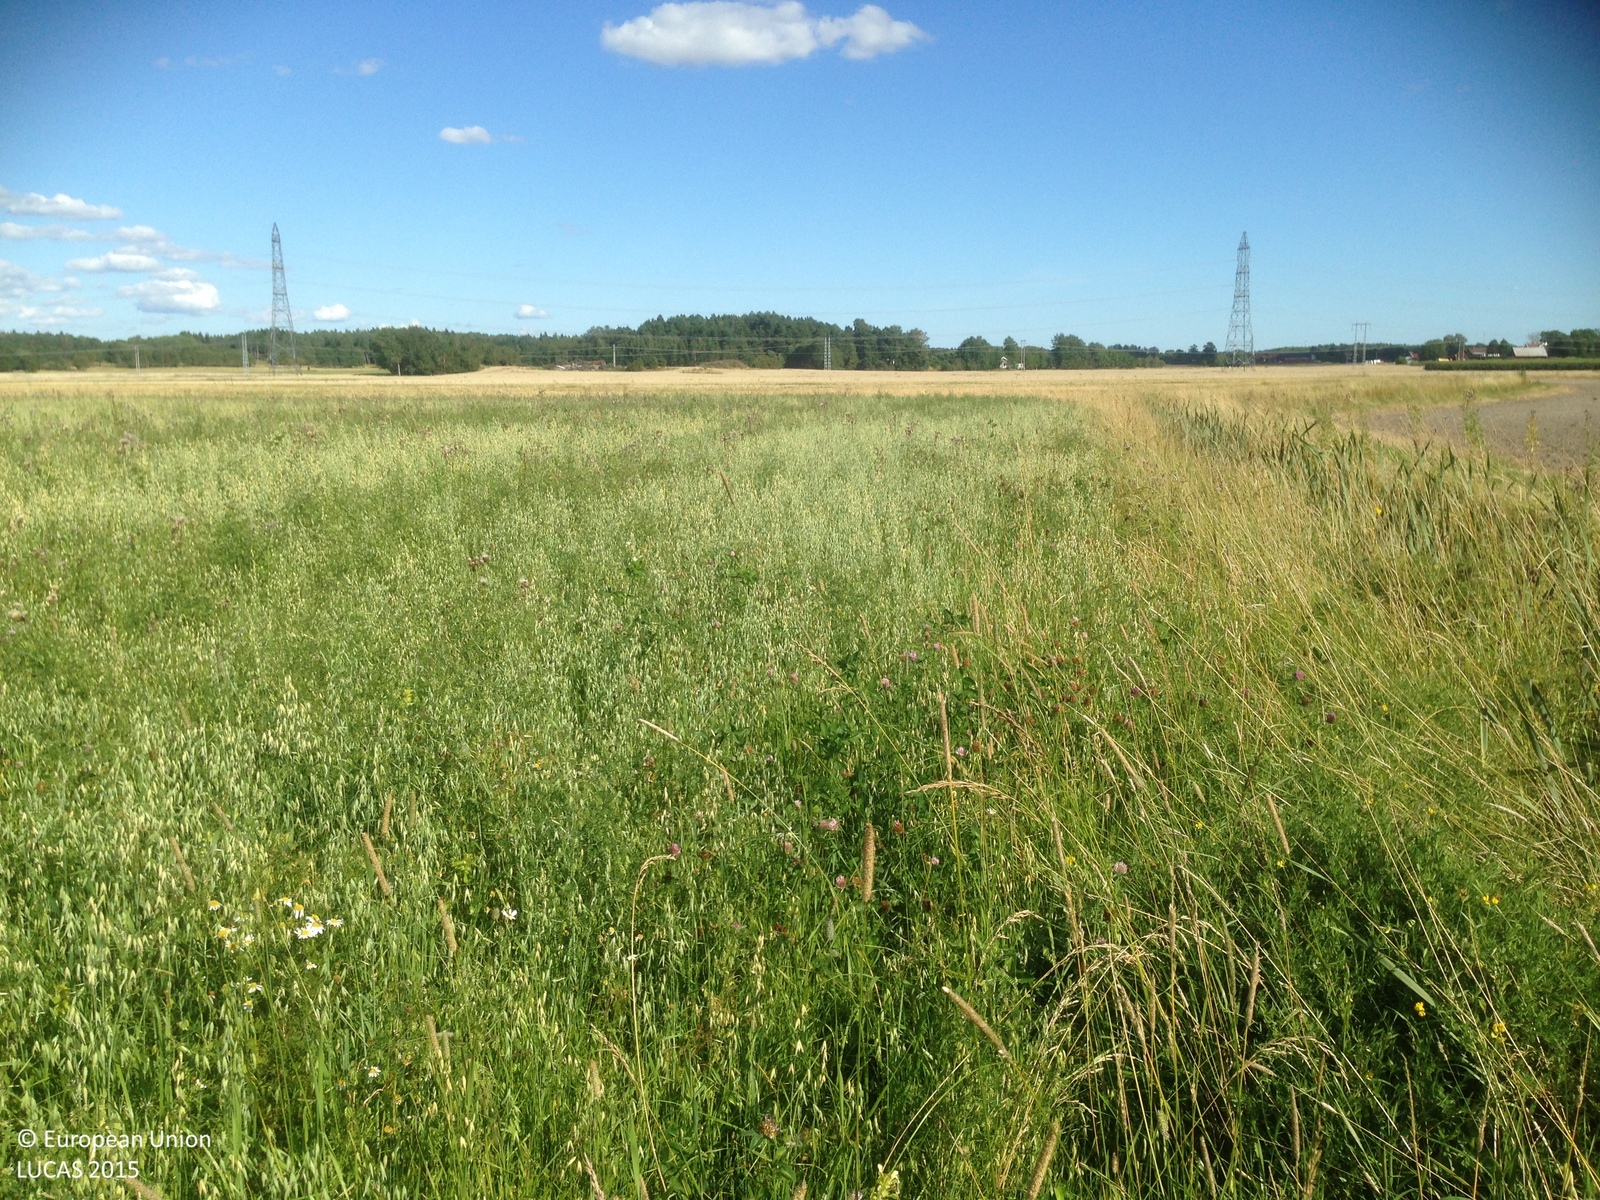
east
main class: Cropland
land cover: Oats
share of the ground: > 75 %
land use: Agriculture (excluding fallow land and kitchen gardens)
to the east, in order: Oats; Ditches and canals; Barley; Common wheat
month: August
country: SE
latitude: 59.6538
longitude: 17.8573
